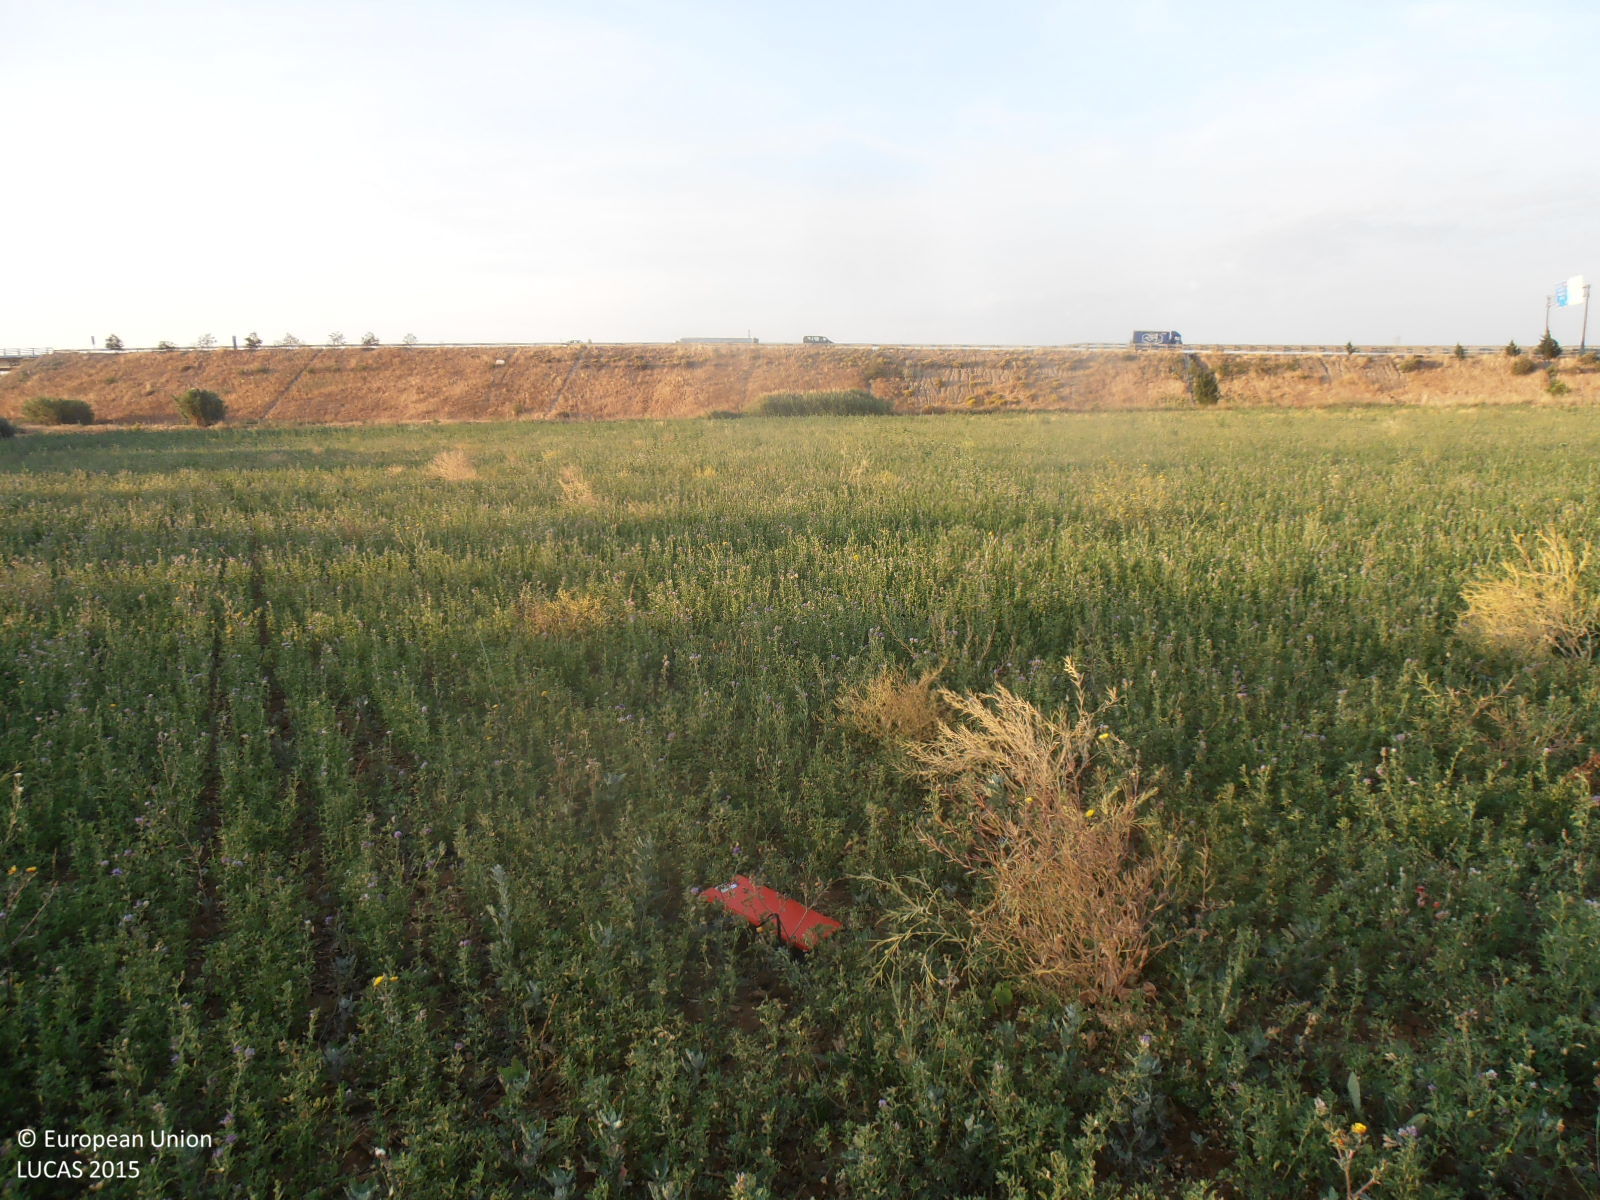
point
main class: Cropland
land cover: Lucerne
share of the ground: > 75 %
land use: Agriculture (excluding fallow land and kitchen gardens)
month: June
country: ES
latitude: 41.6922
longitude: -0.9686
